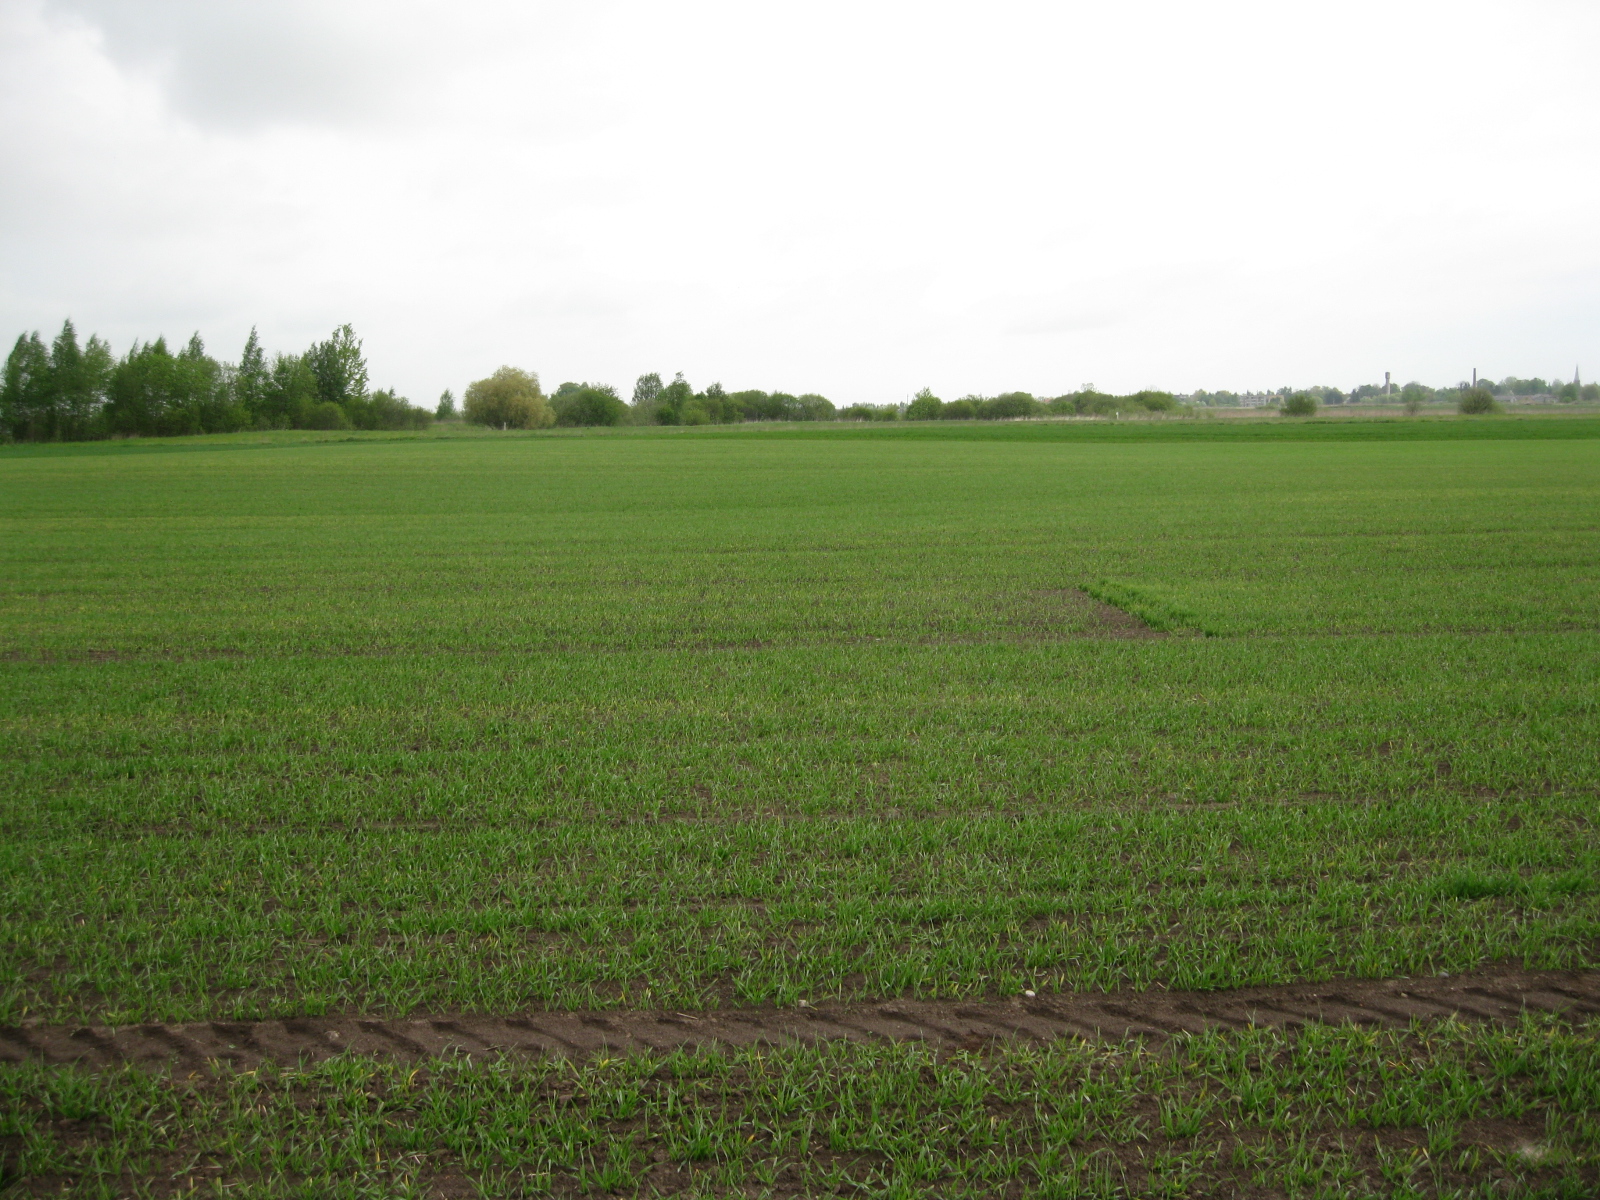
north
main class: Cropland
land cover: Barley
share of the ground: 10 - 25 %
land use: Agriculture (excluding fallow land and kitchen gardens)
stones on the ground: < 10 %
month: May
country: LT
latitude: 56.2577
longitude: 23.9845
